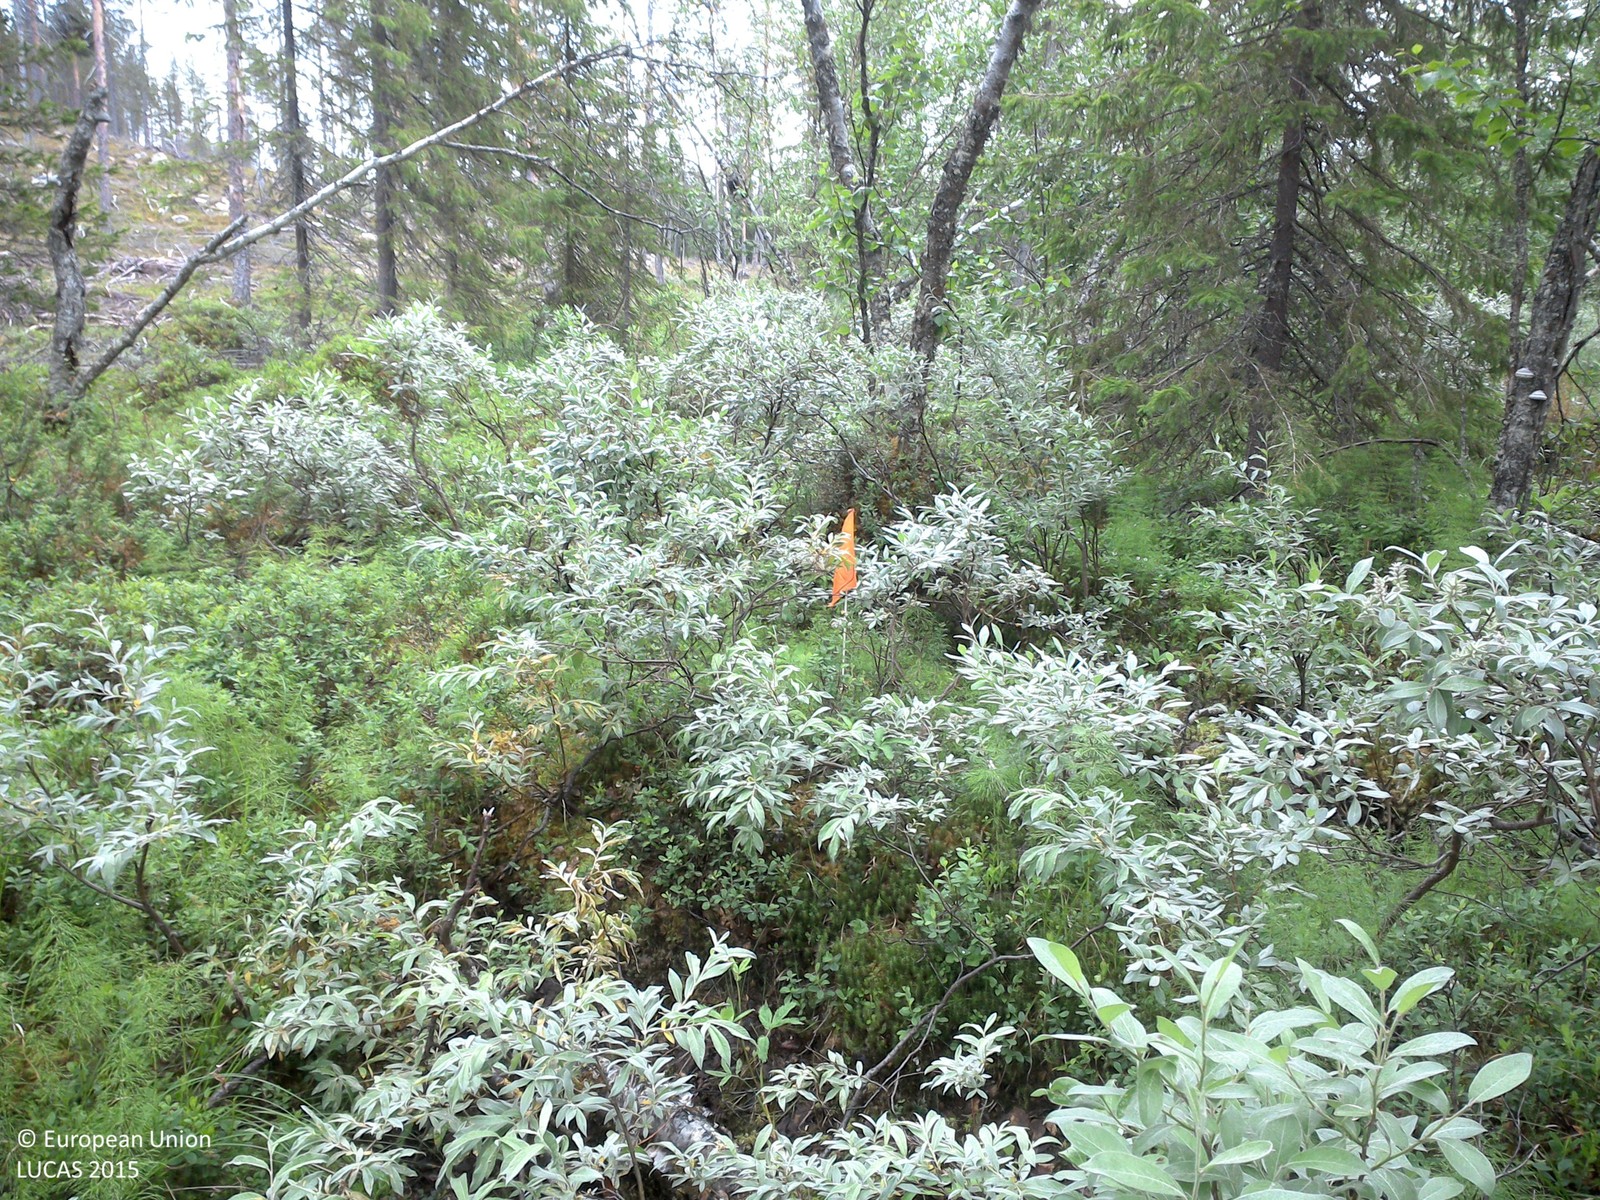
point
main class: Woodland
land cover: Spruce dominated mixed woodland
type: boreal forest
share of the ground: 25 - 50 %
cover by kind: shrubs 35 %, herbaceous plants 25 %, coniferous forest trees 20 %, broadleaved forest trees 15 %, lichens and mosses 5 %
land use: Forestry
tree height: > 5 m
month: July
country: SE
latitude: 67.7530
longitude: 23.0965
